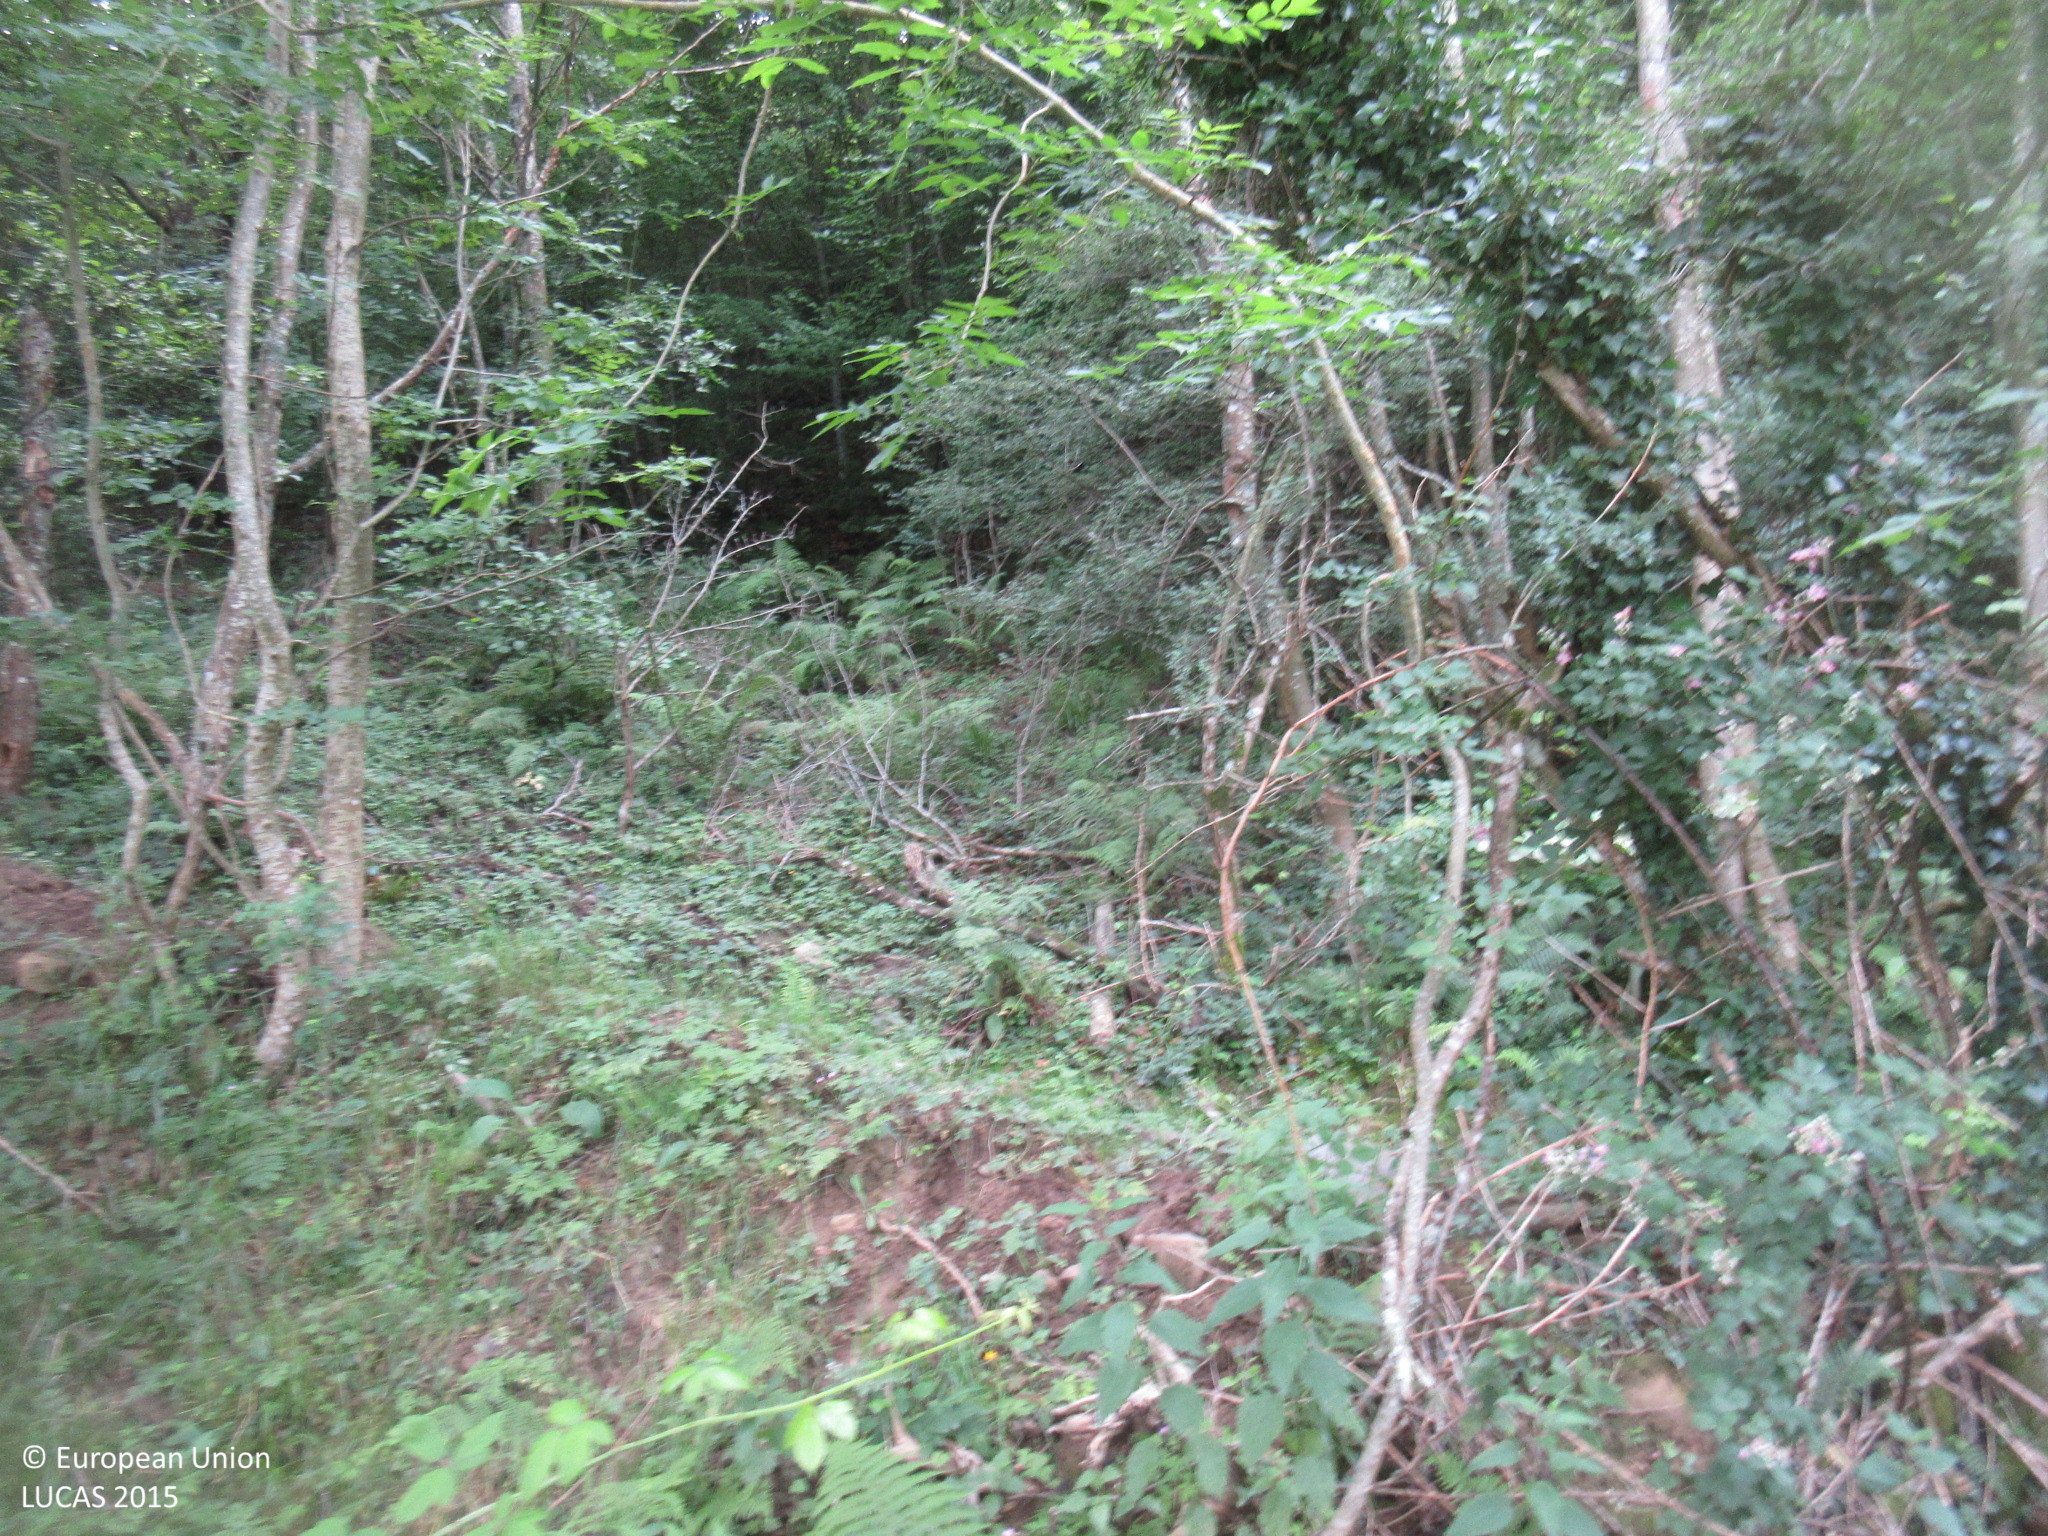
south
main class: Woodland
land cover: Broadleaved woodland
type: thermophilous deciduous forest
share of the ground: > 75 %
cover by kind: broadleaved forest trees 85 %, shrubs 15 %
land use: Semi-natural and natural areas not in use
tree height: > 5 m
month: July
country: ES
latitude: 43.1522
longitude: -3.5068
